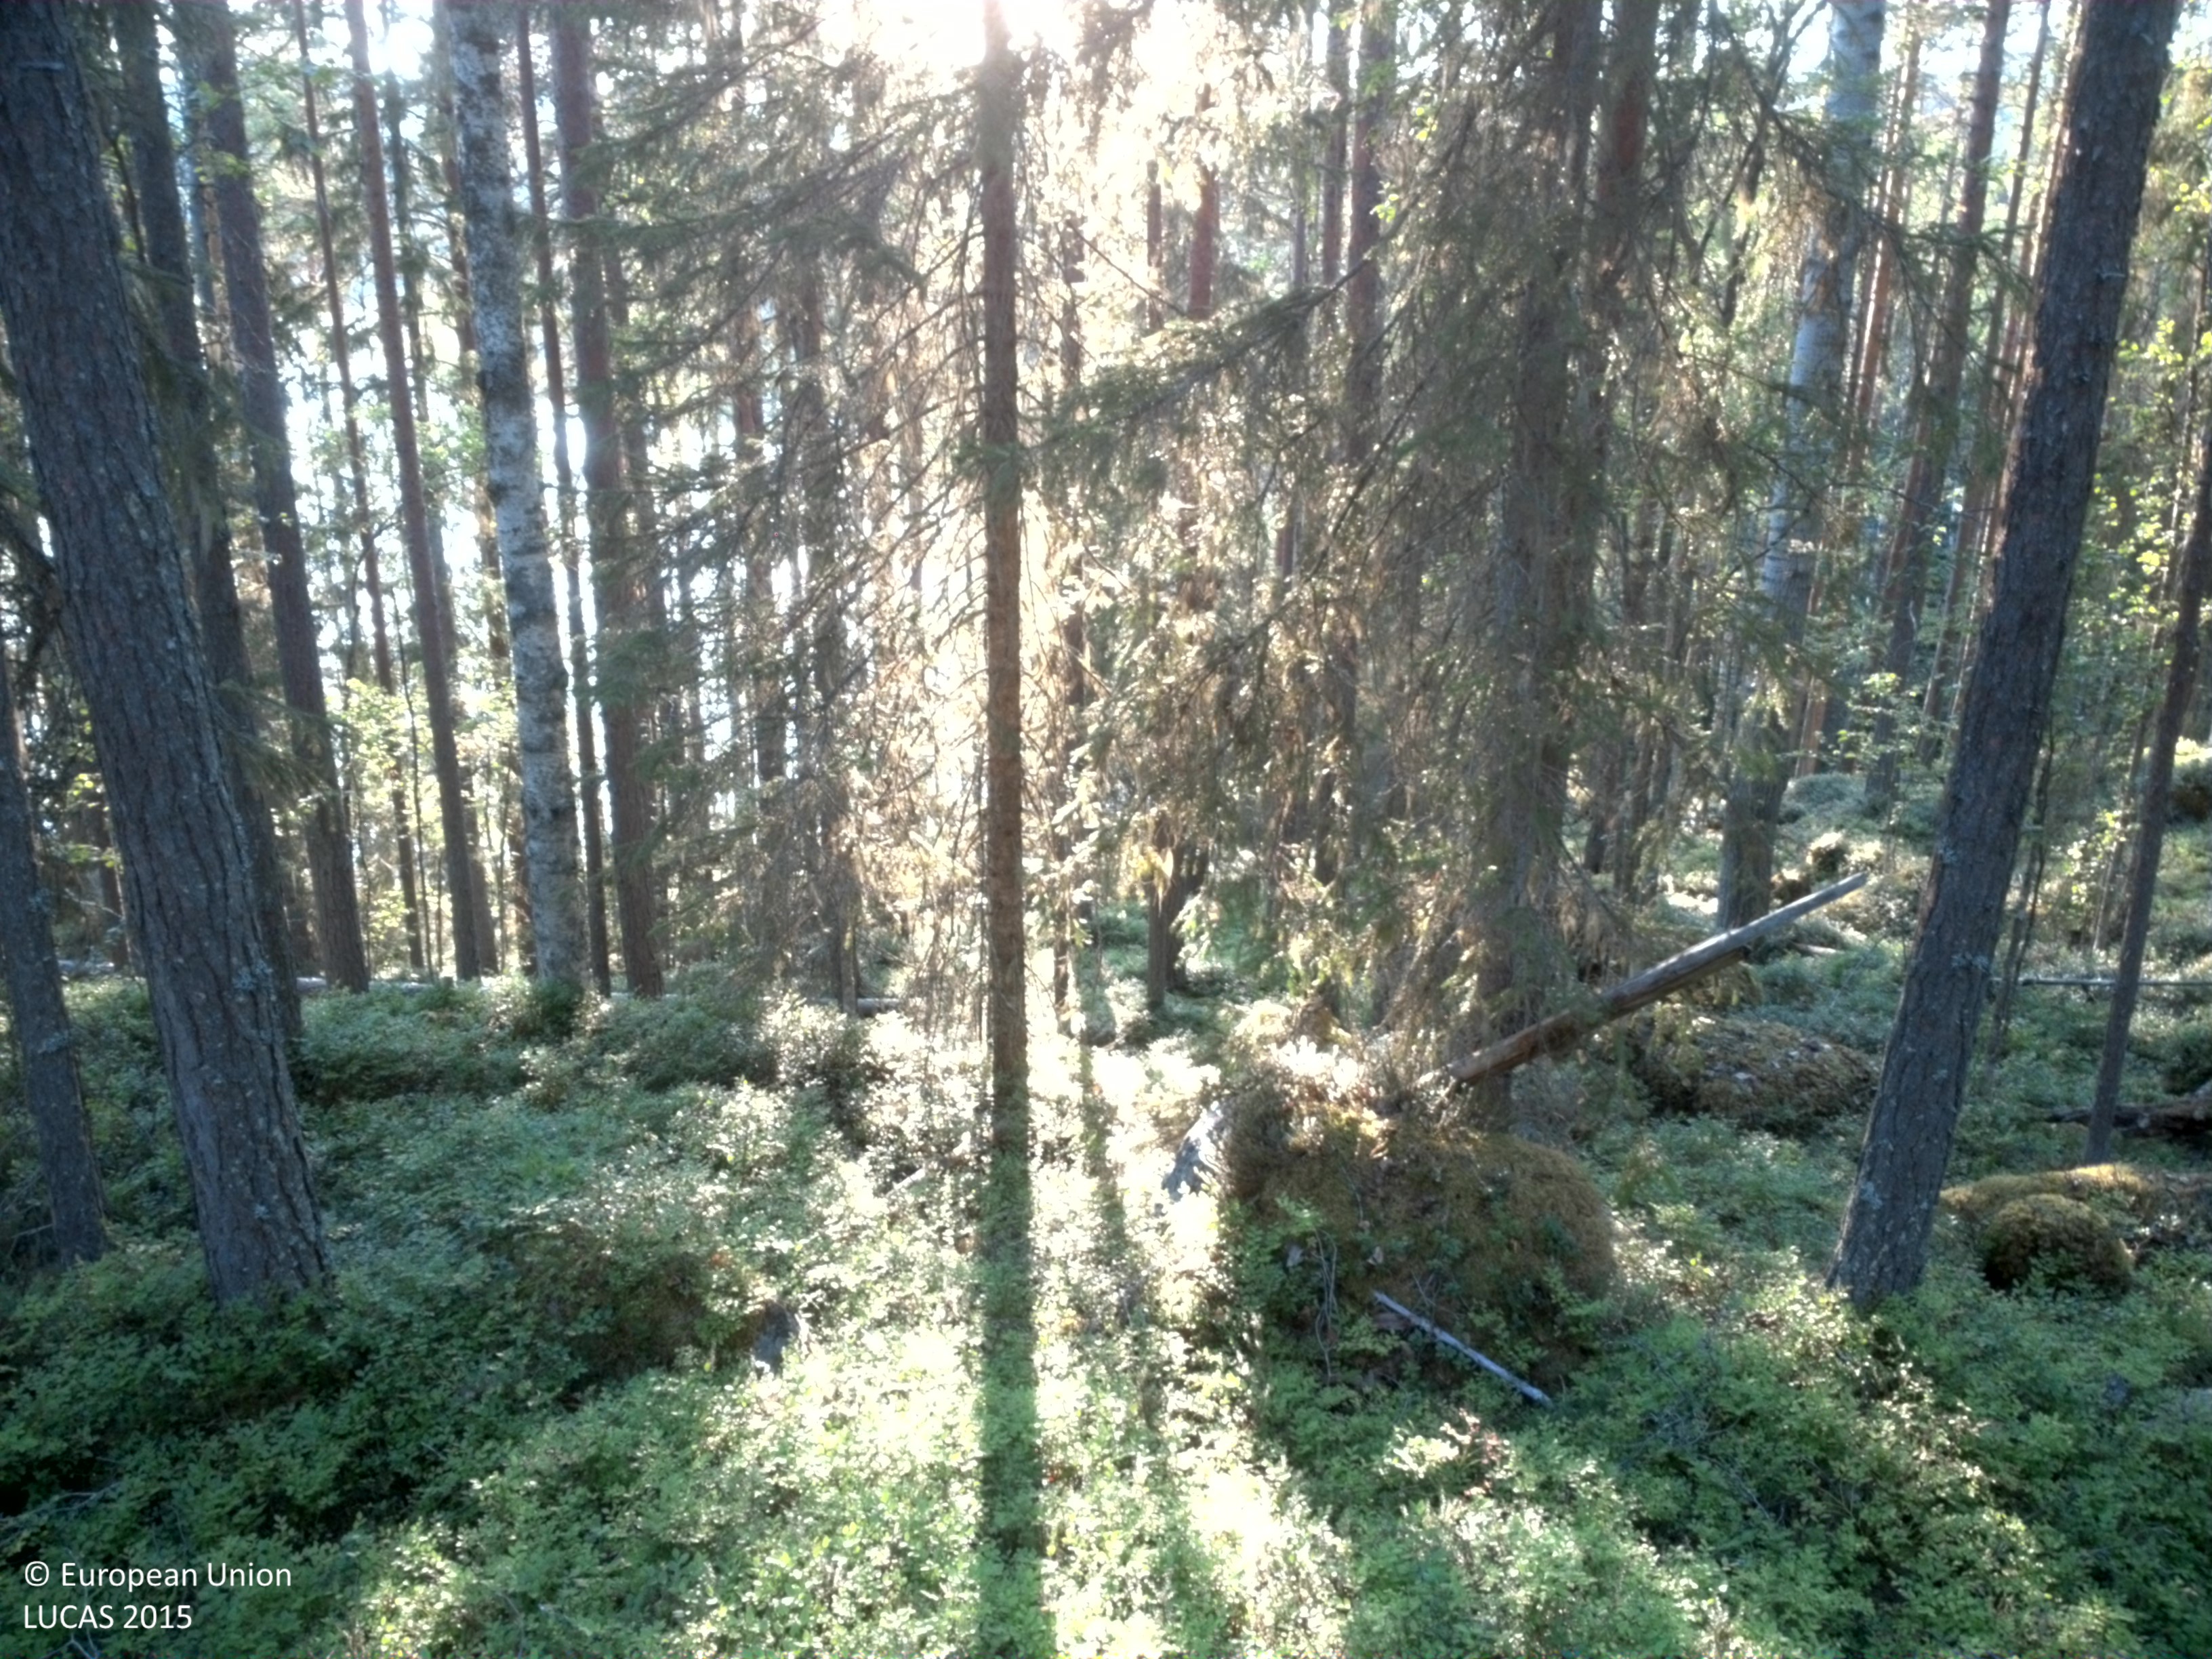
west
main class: Woodland
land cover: Pine dominated coniferous woodland
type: boreal forest
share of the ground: 25 - 50 %
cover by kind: coniferous forest trees 50 %, shrubs 50 %
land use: Forestry
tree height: > 5 m
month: August
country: SE
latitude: 64.4666
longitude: 19.0568
